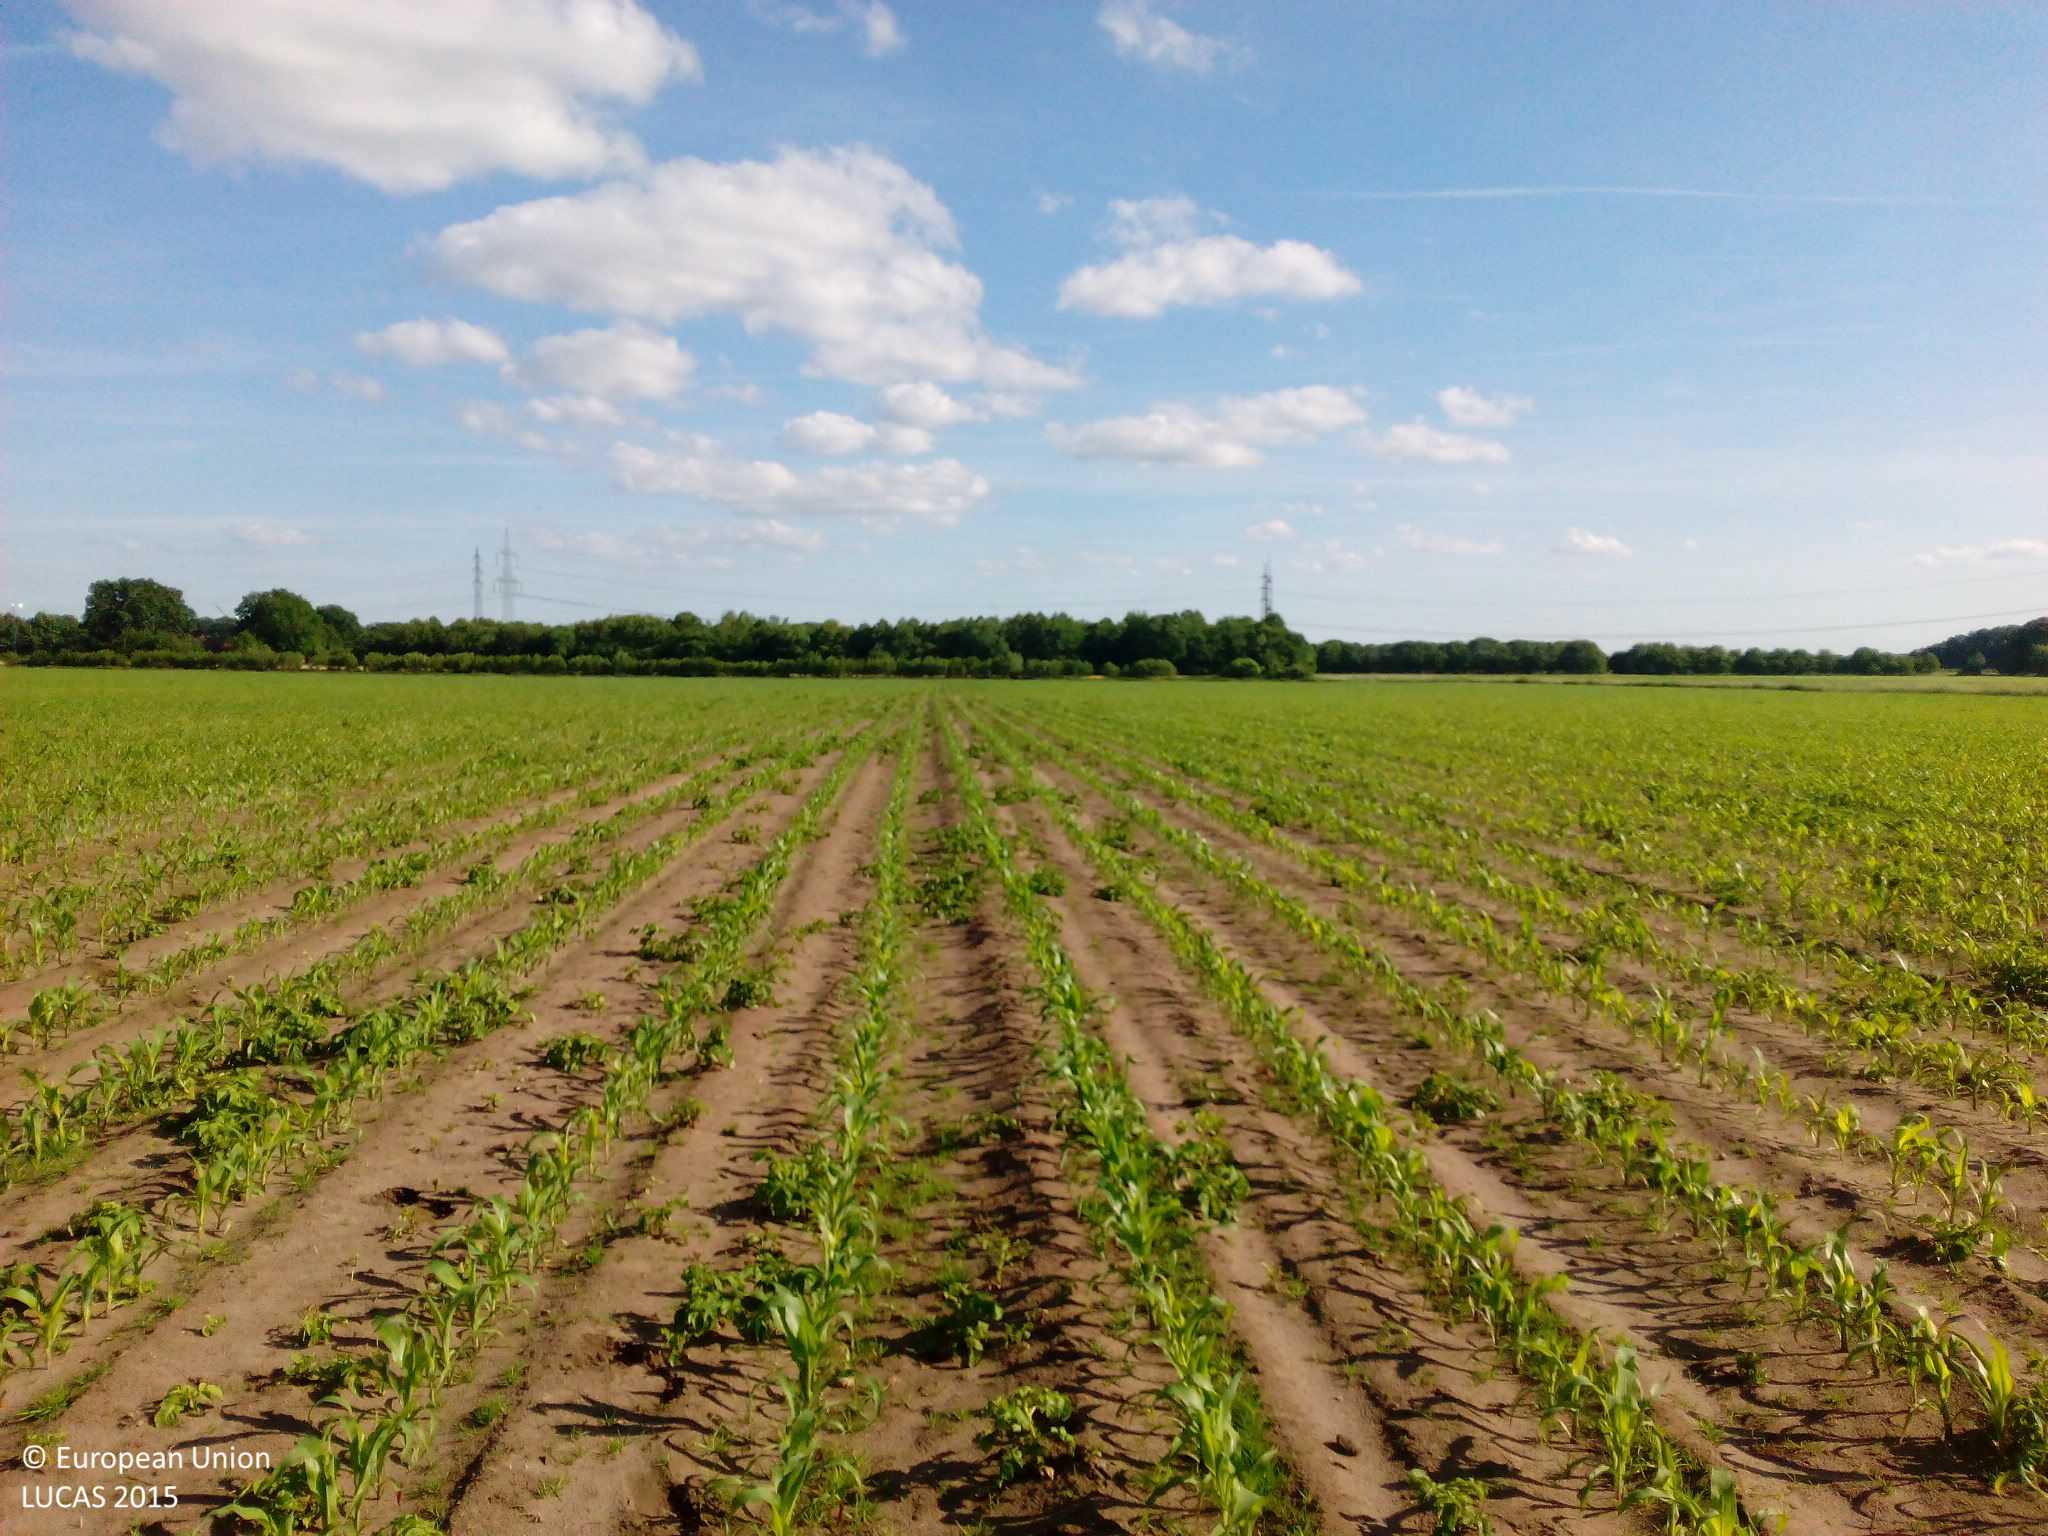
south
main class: Cropland
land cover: Maize
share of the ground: 10 - 25 %
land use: Agriculture (excluding fallow land and kitchen gardens)
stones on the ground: < 10 %
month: June
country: DE
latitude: 52.4754
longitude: 7.4239
